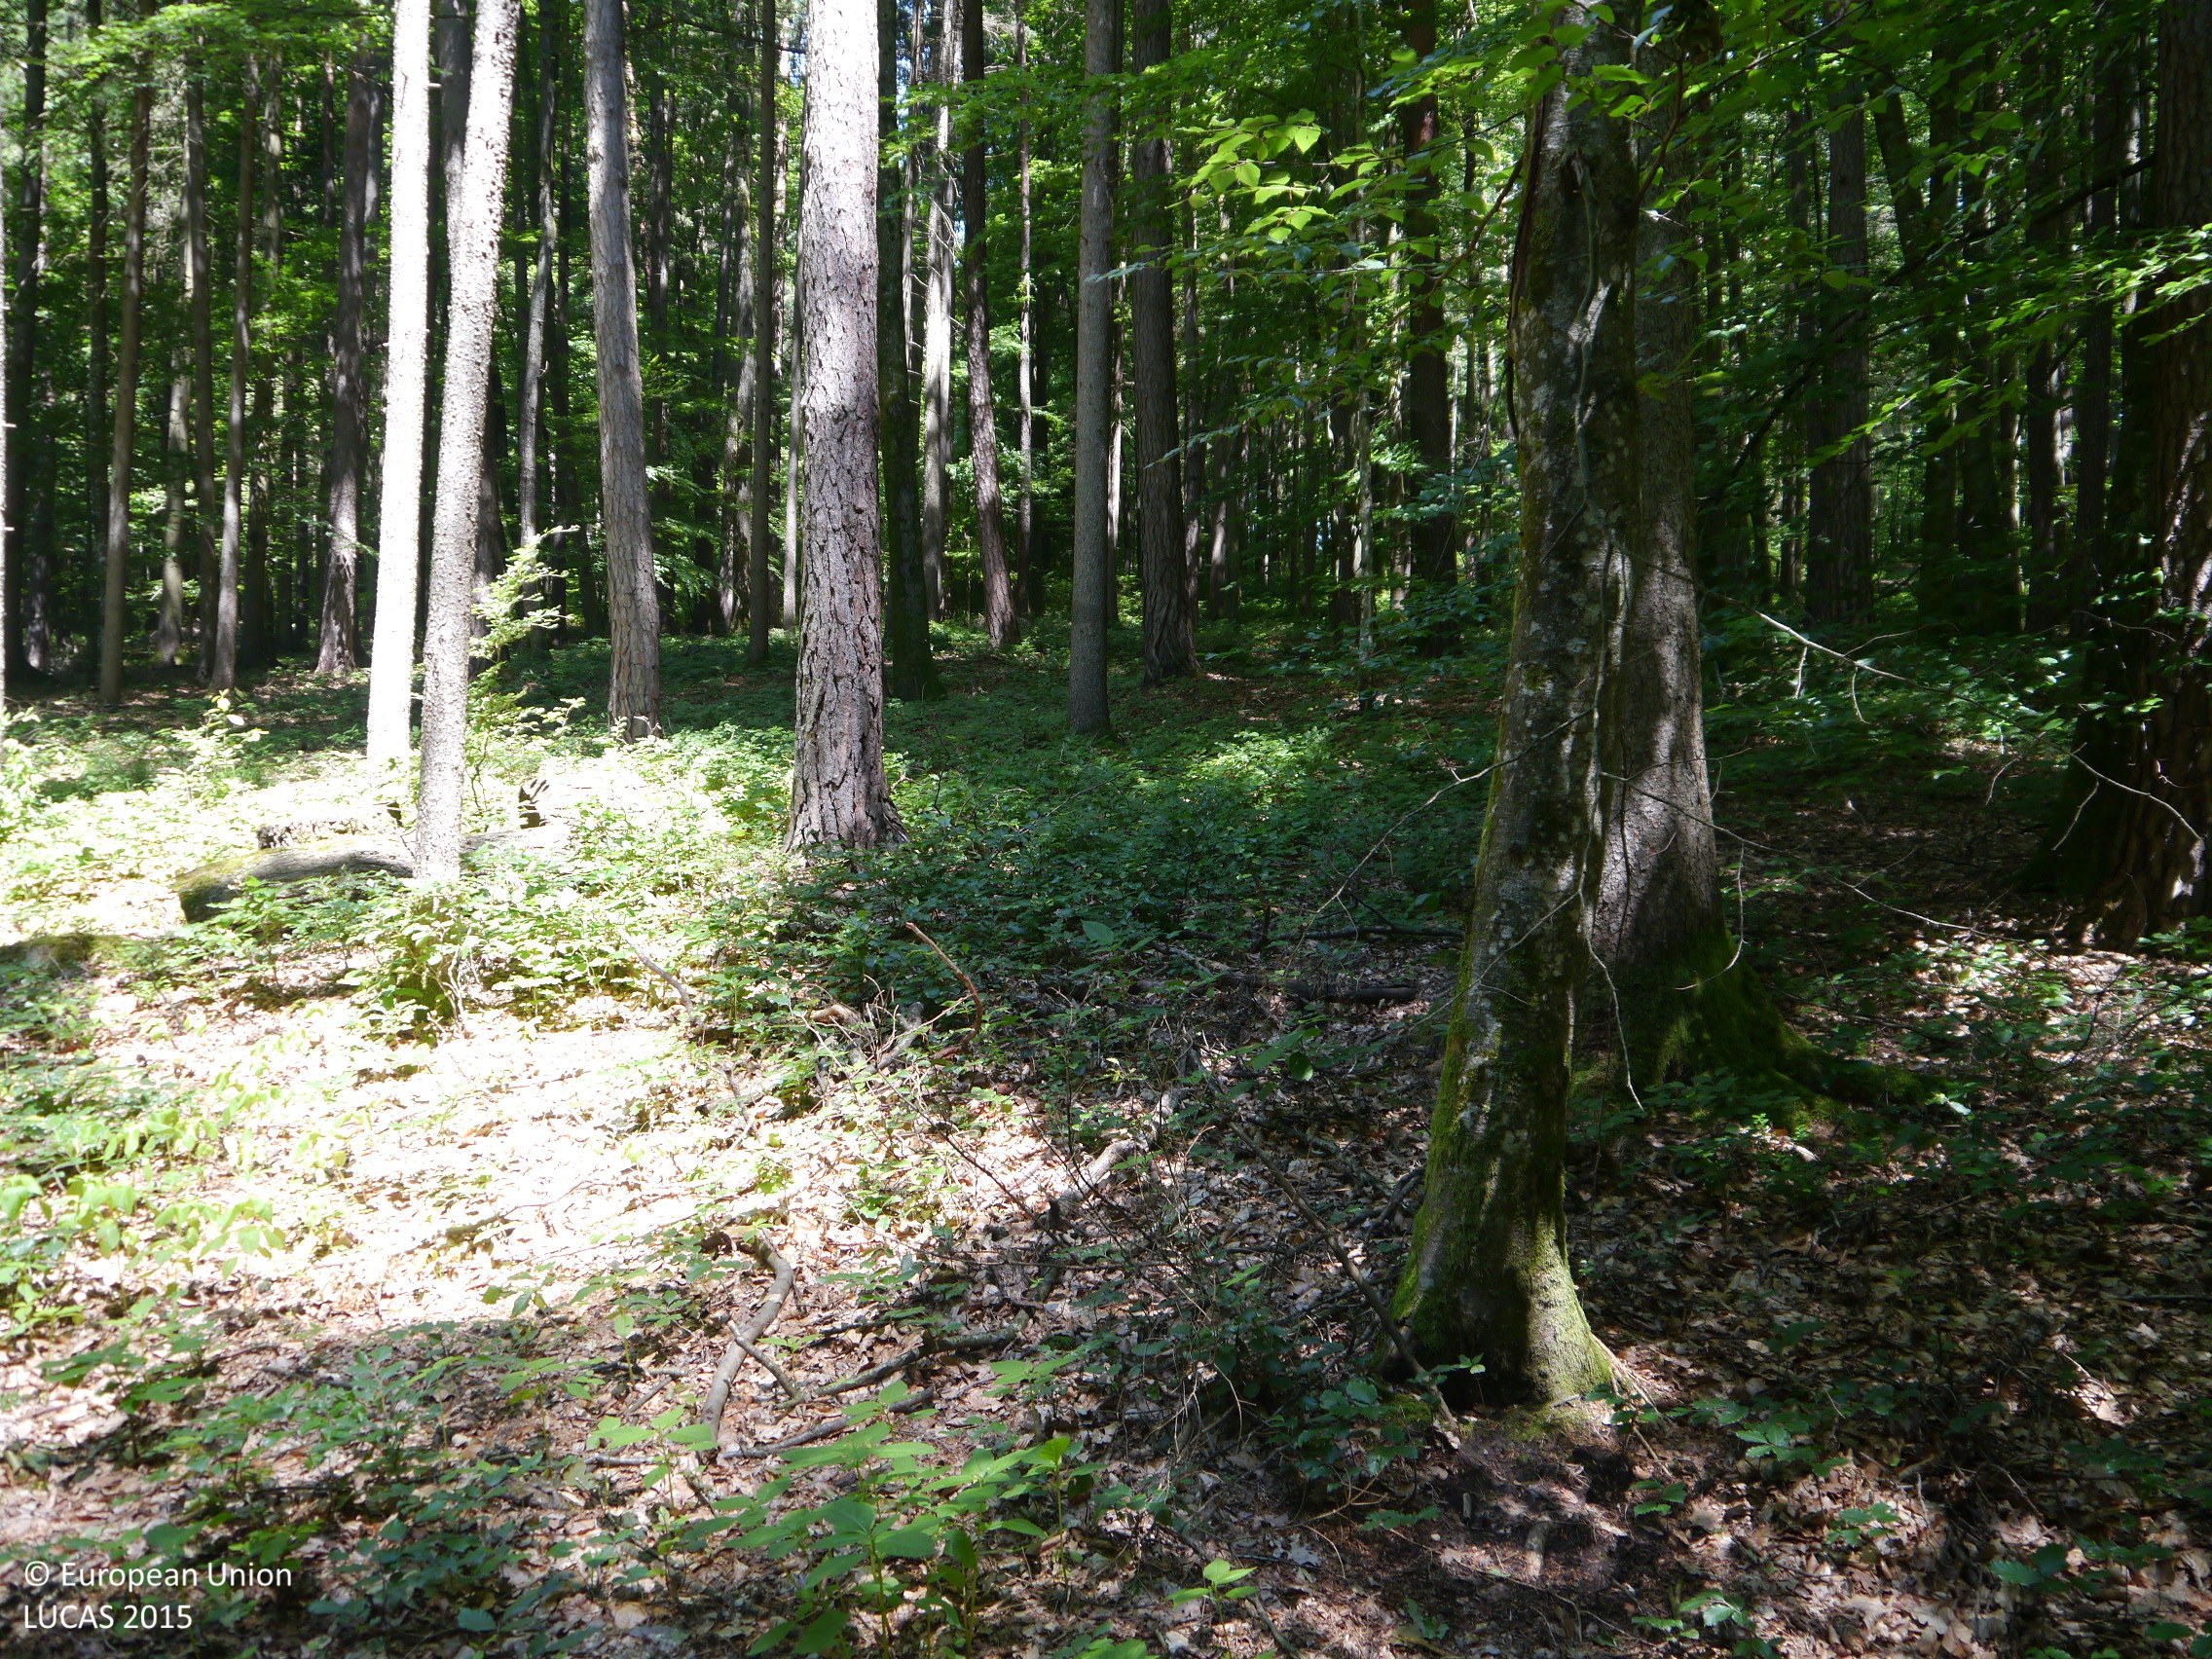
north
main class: Woodland
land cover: Other mixed woodland
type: mountainous beech forest
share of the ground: > 75 %
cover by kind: broadleaved forest trees 70 %, coniferous forest trees 30 %
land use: Forestry
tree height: > 5 m
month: June
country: AT
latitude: 46.9055
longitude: 15.6581
